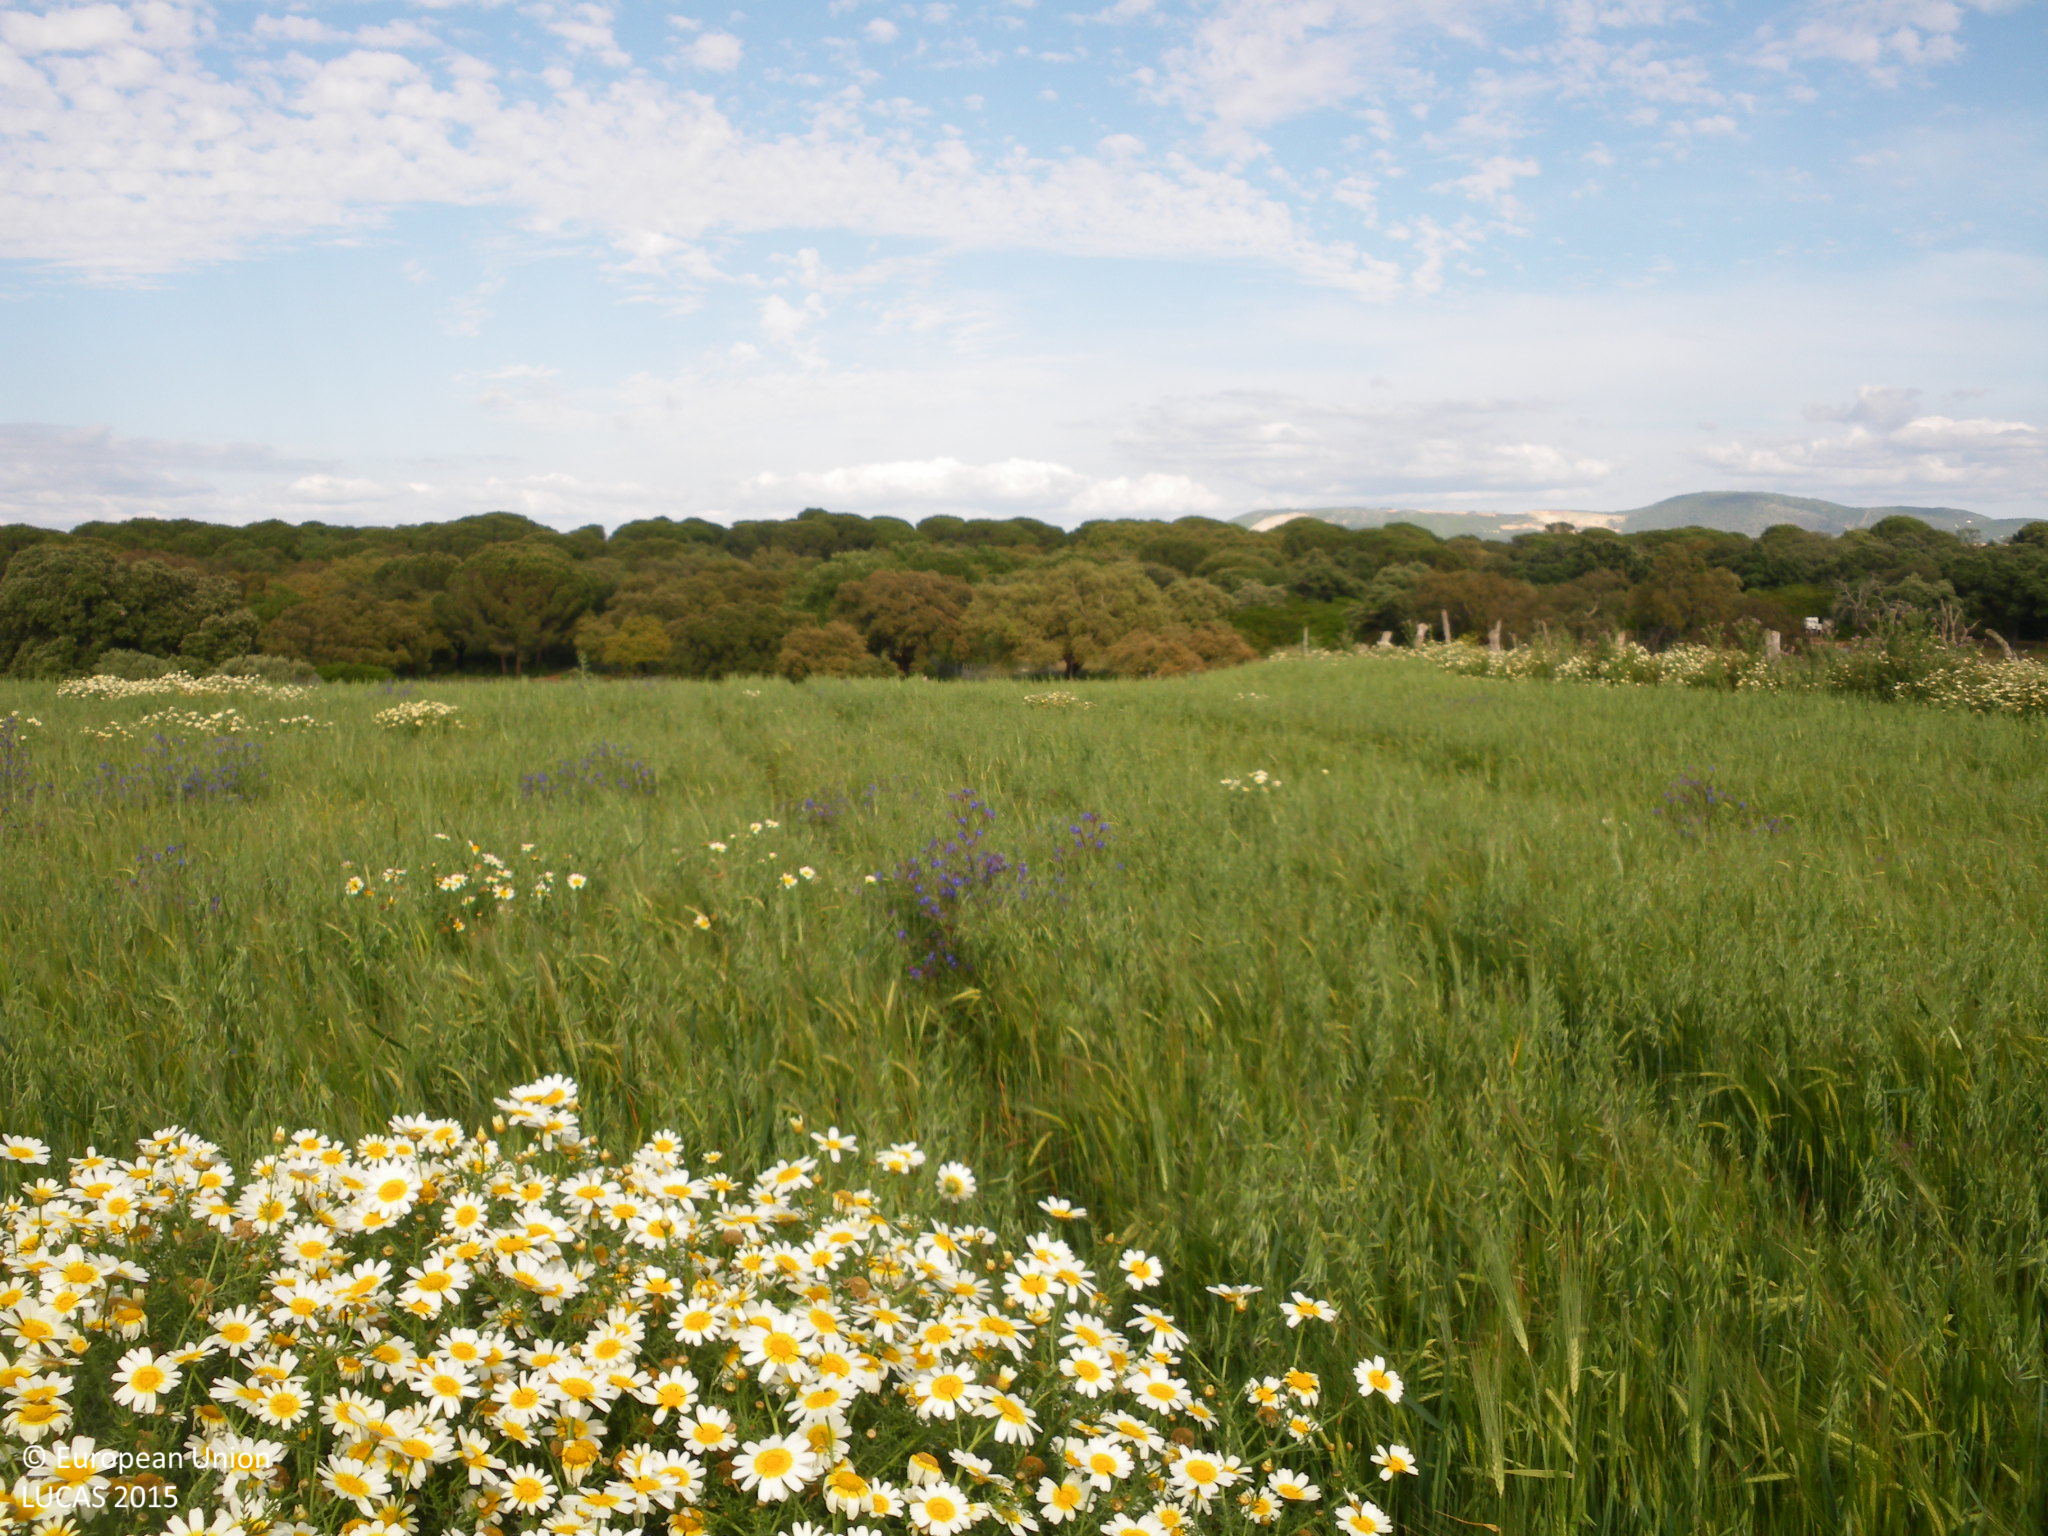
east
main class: Cropland
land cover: Mixed cereals for fodder
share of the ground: > 75 %
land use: Agriculture (excluding fallow land and kitchen gardens)
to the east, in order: Mixed cereals for fodder; Grass margins; Fences; Other fruit trees and berries; Grassland with sparse tree/shrub cover; Artificial constructions; Other fruit trees and berries; Fences; Grass margins; Sugar beet; Shrubland without tree cover; Rivers and streams; Grass margins; Fences; Grass margins; Tracks; Grass margins; Tracks; Grass margins; Fences; Broadleaved woodland; Fences; Broadleaved woodland
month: April
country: ES
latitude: 36.6046
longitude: -5.8928
